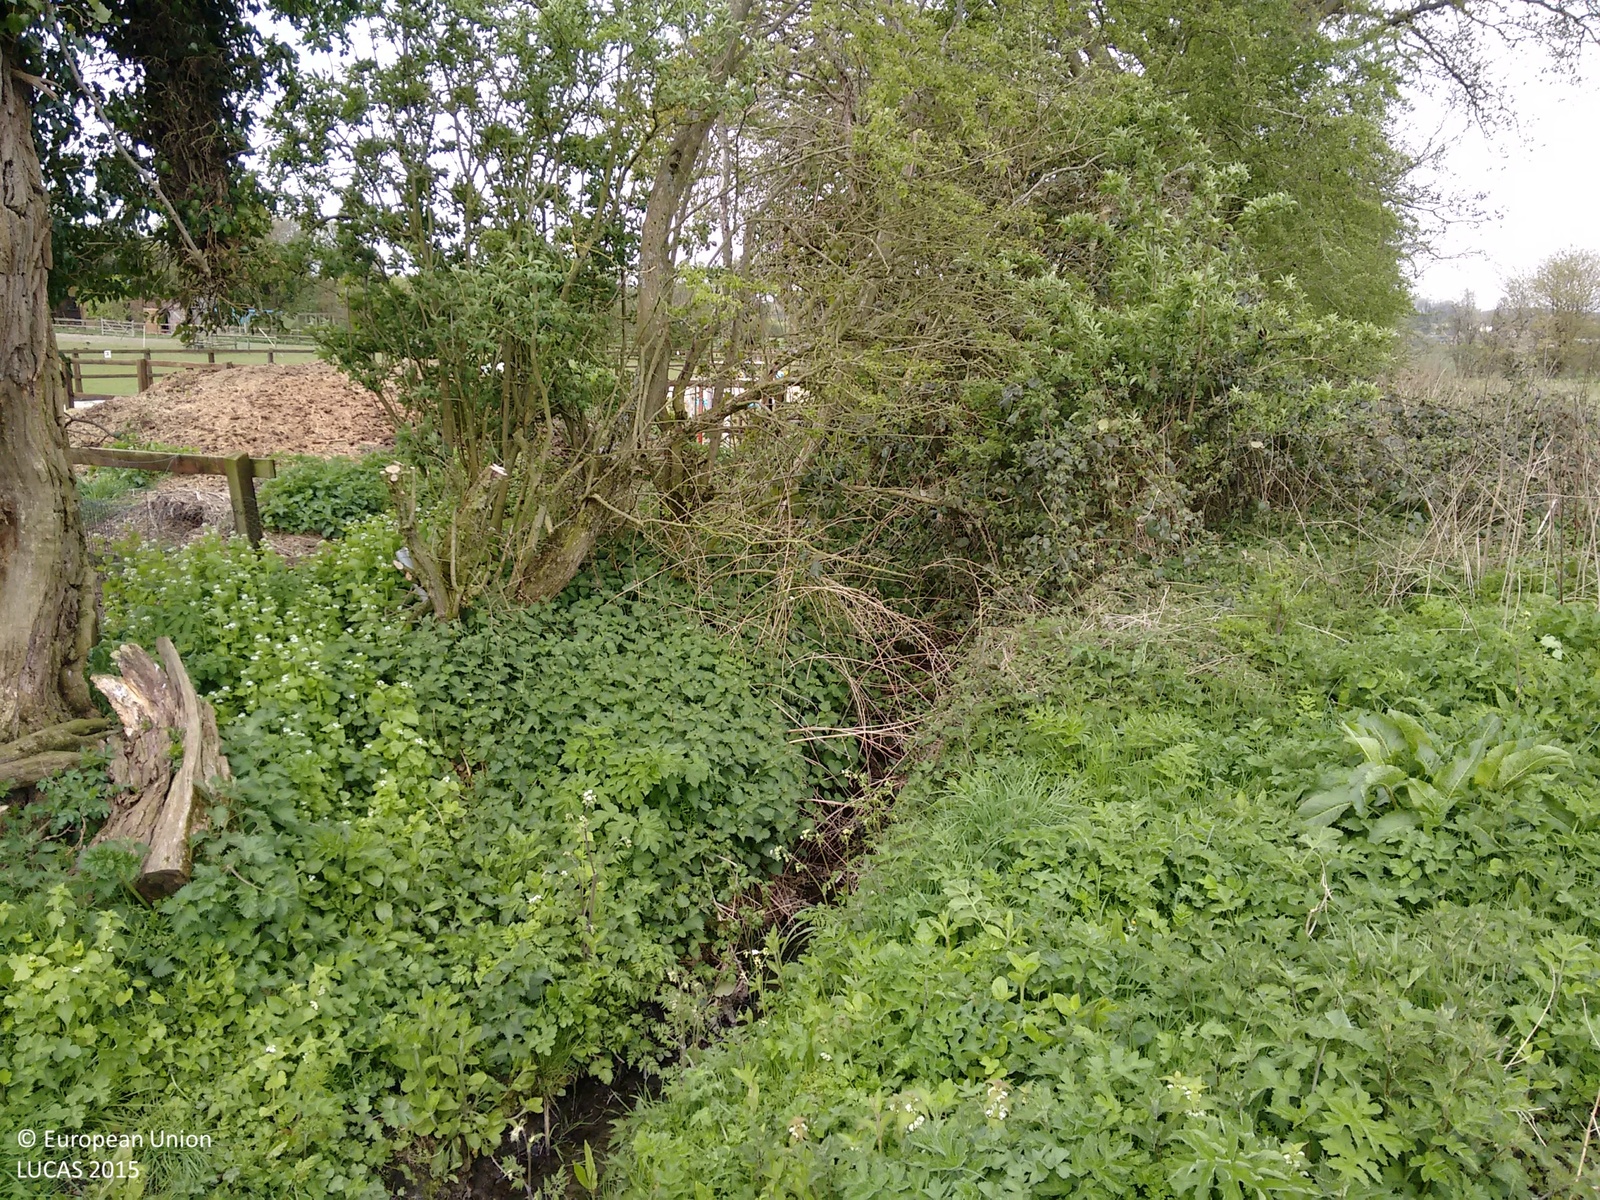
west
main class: Grassland
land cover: Grassland without tree/shrub cover
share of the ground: > 75 %
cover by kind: herbaceous plants 100 %
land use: Residential
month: May
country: GB
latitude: 51.1433
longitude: -0.9500
